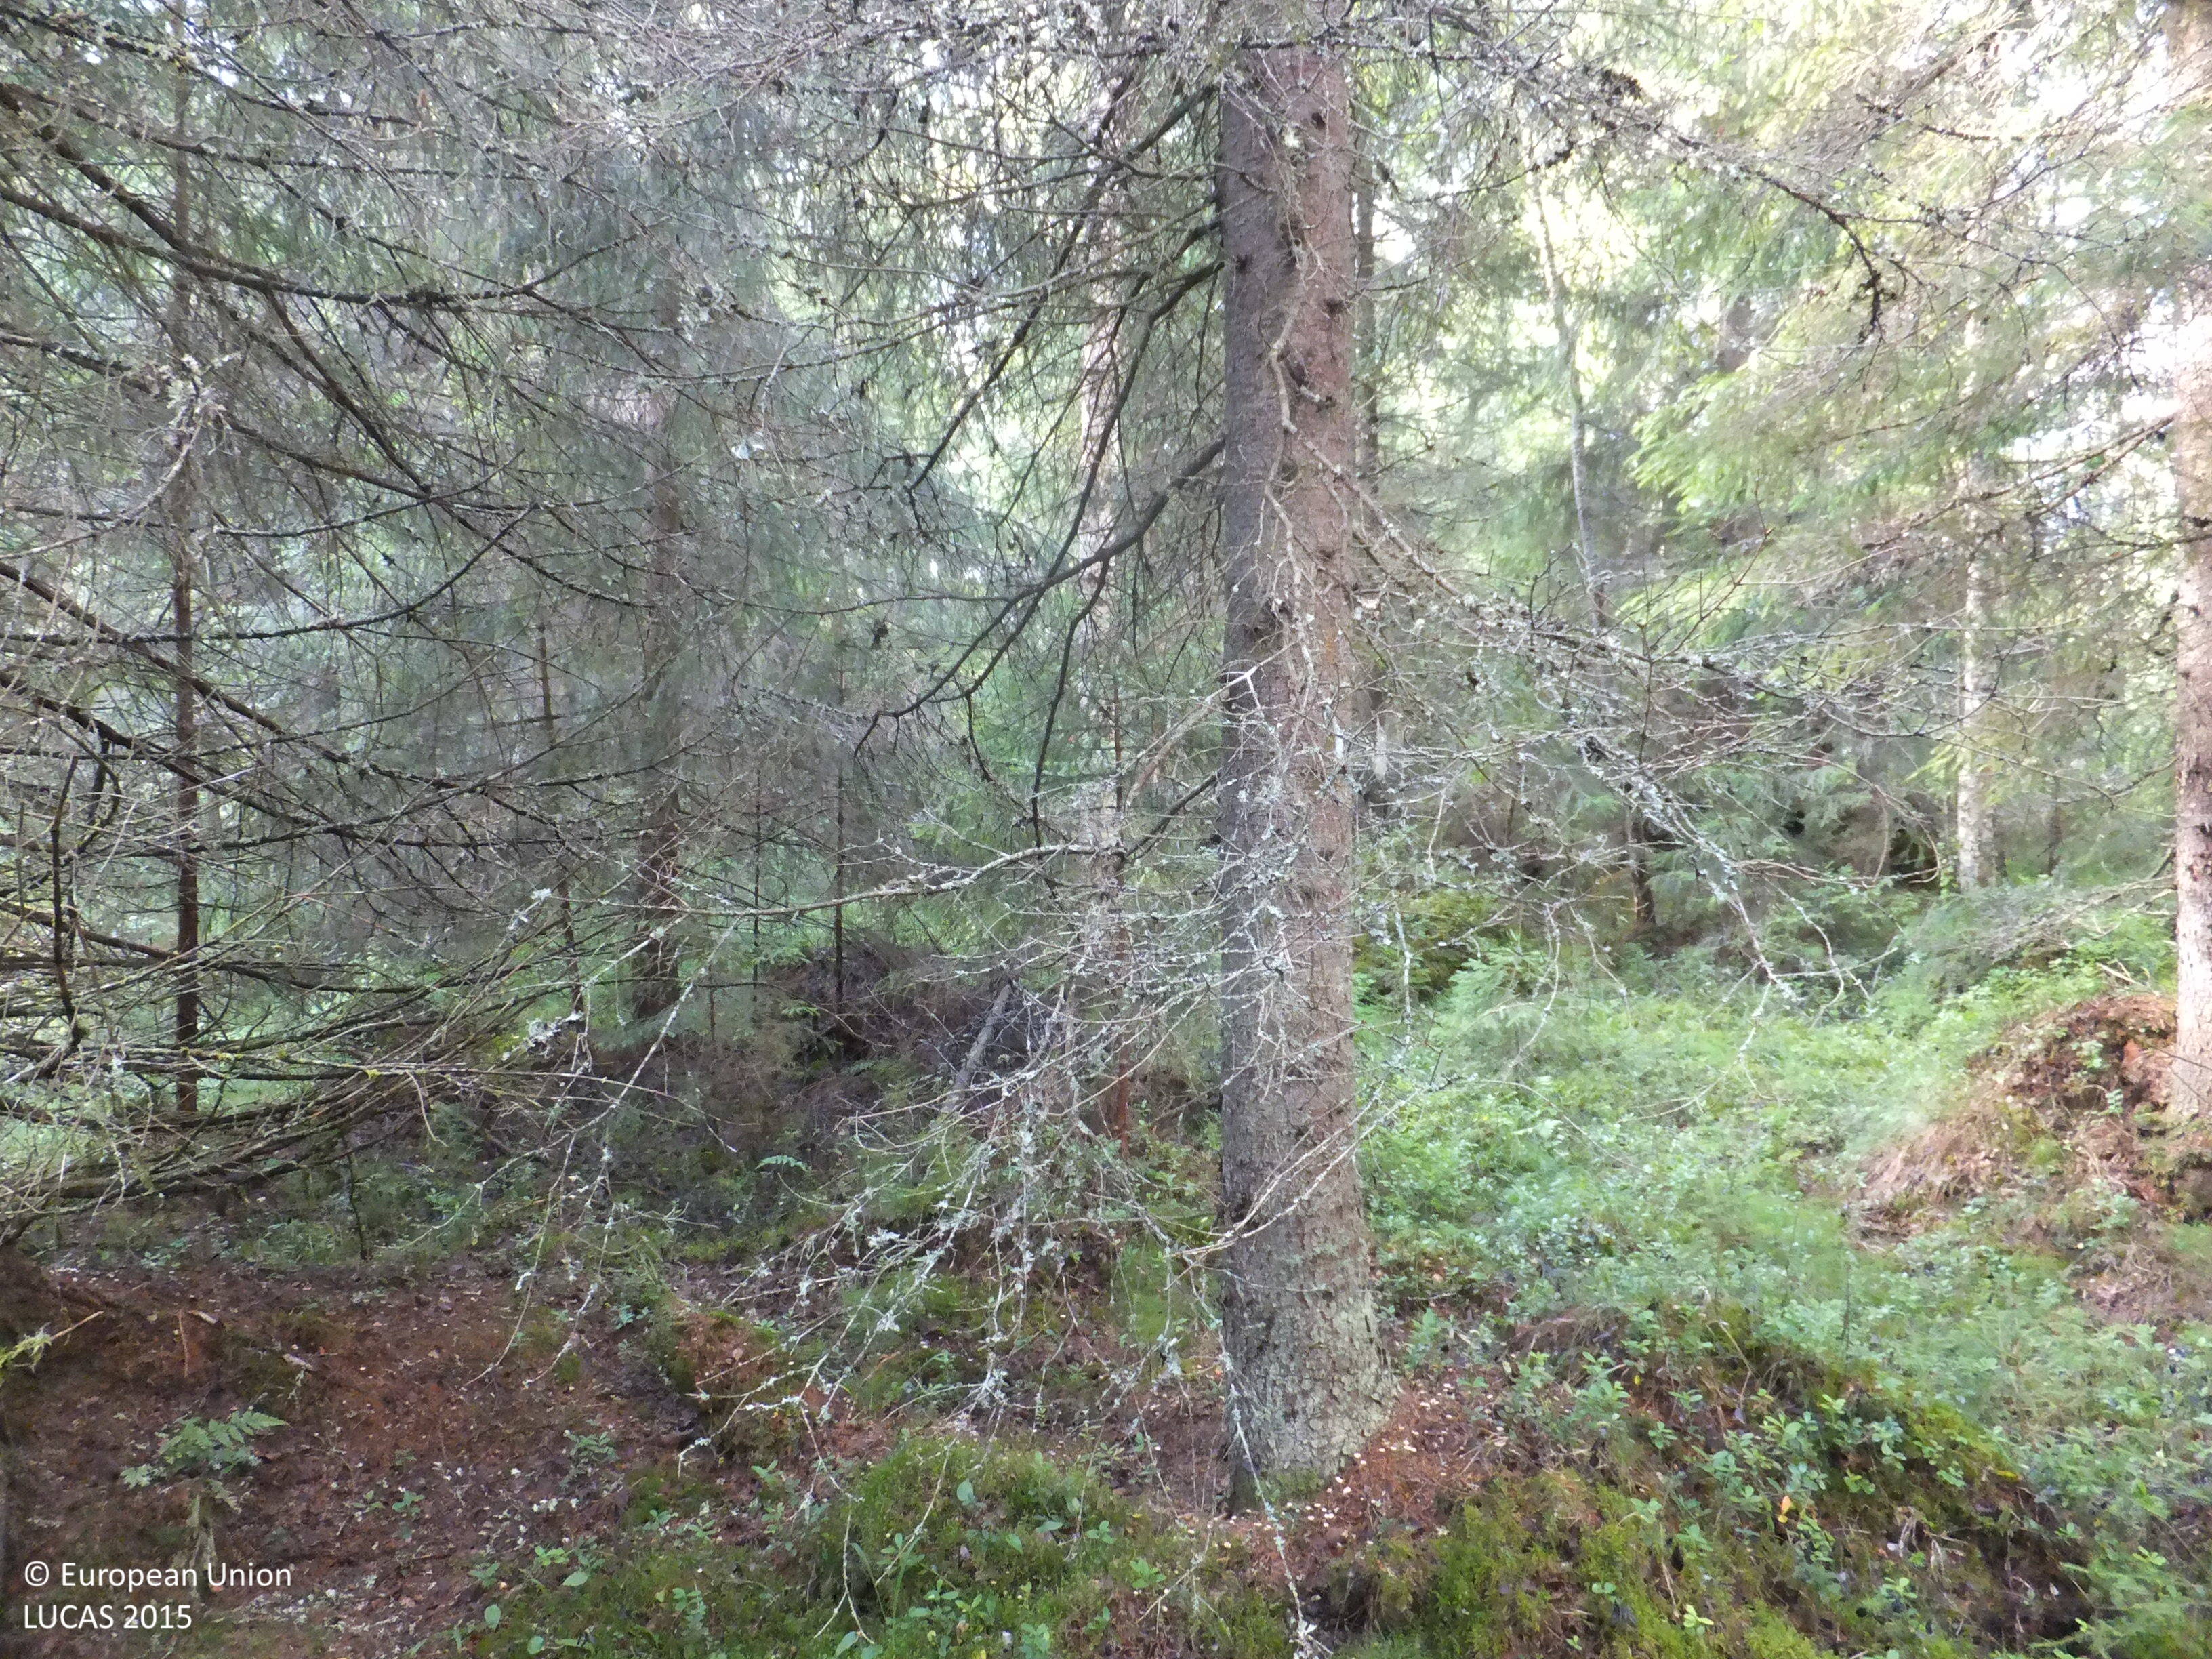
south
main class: Woodland
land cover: Spruce dominated mixed woodland
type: boreal forest
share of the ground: > 75 %
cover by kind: coniferous forest trees 55 %, broadleaved forest trees 30 %, shrubs 5 %, herbaceous plants 5 %, lichens and mosses 5 %
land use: Forestry
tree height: > 5 m
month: August
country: FI
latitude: 63.1233
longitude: 22.1606
